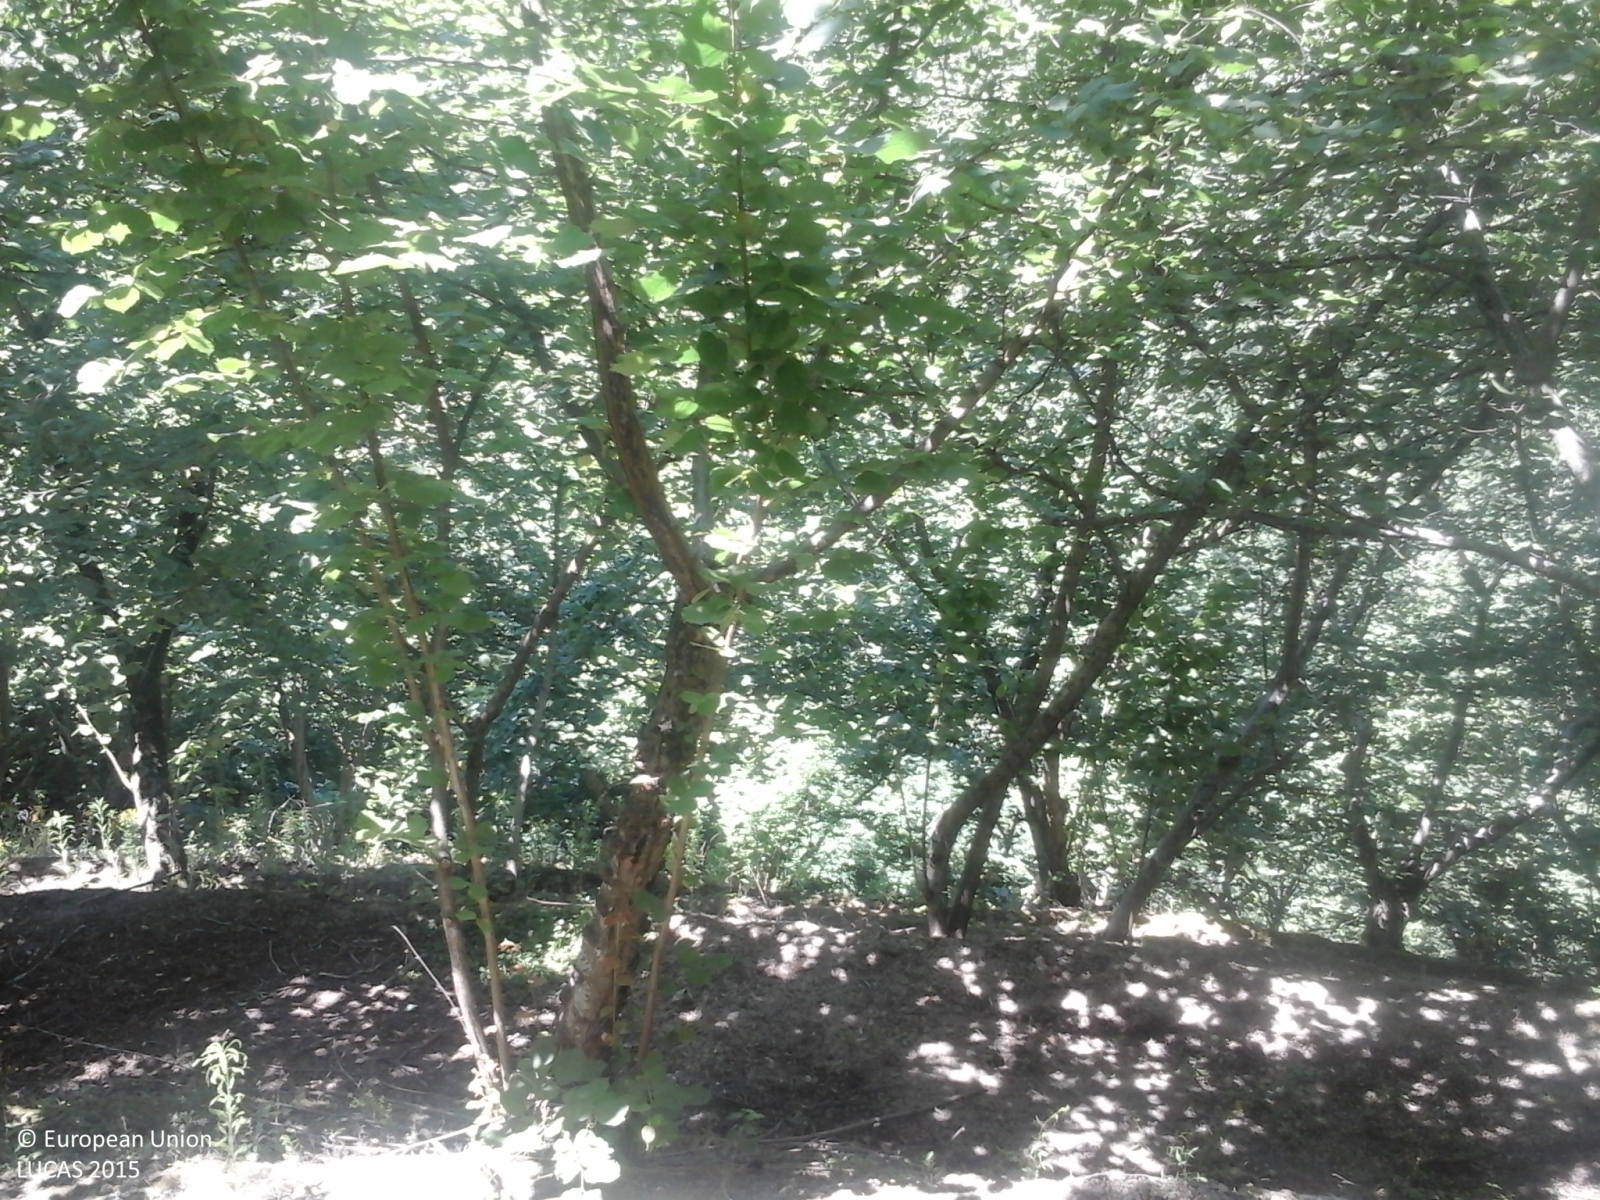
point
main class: Cropland
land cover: Nuts trees
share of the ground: > 75 %
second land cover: Spontaneously vegetated surfaces
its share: > 75 %
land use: Agriculture (excluding fallow land and kitchen gardens)
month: July
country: IT
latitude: 40.8991
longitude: 14.6700
